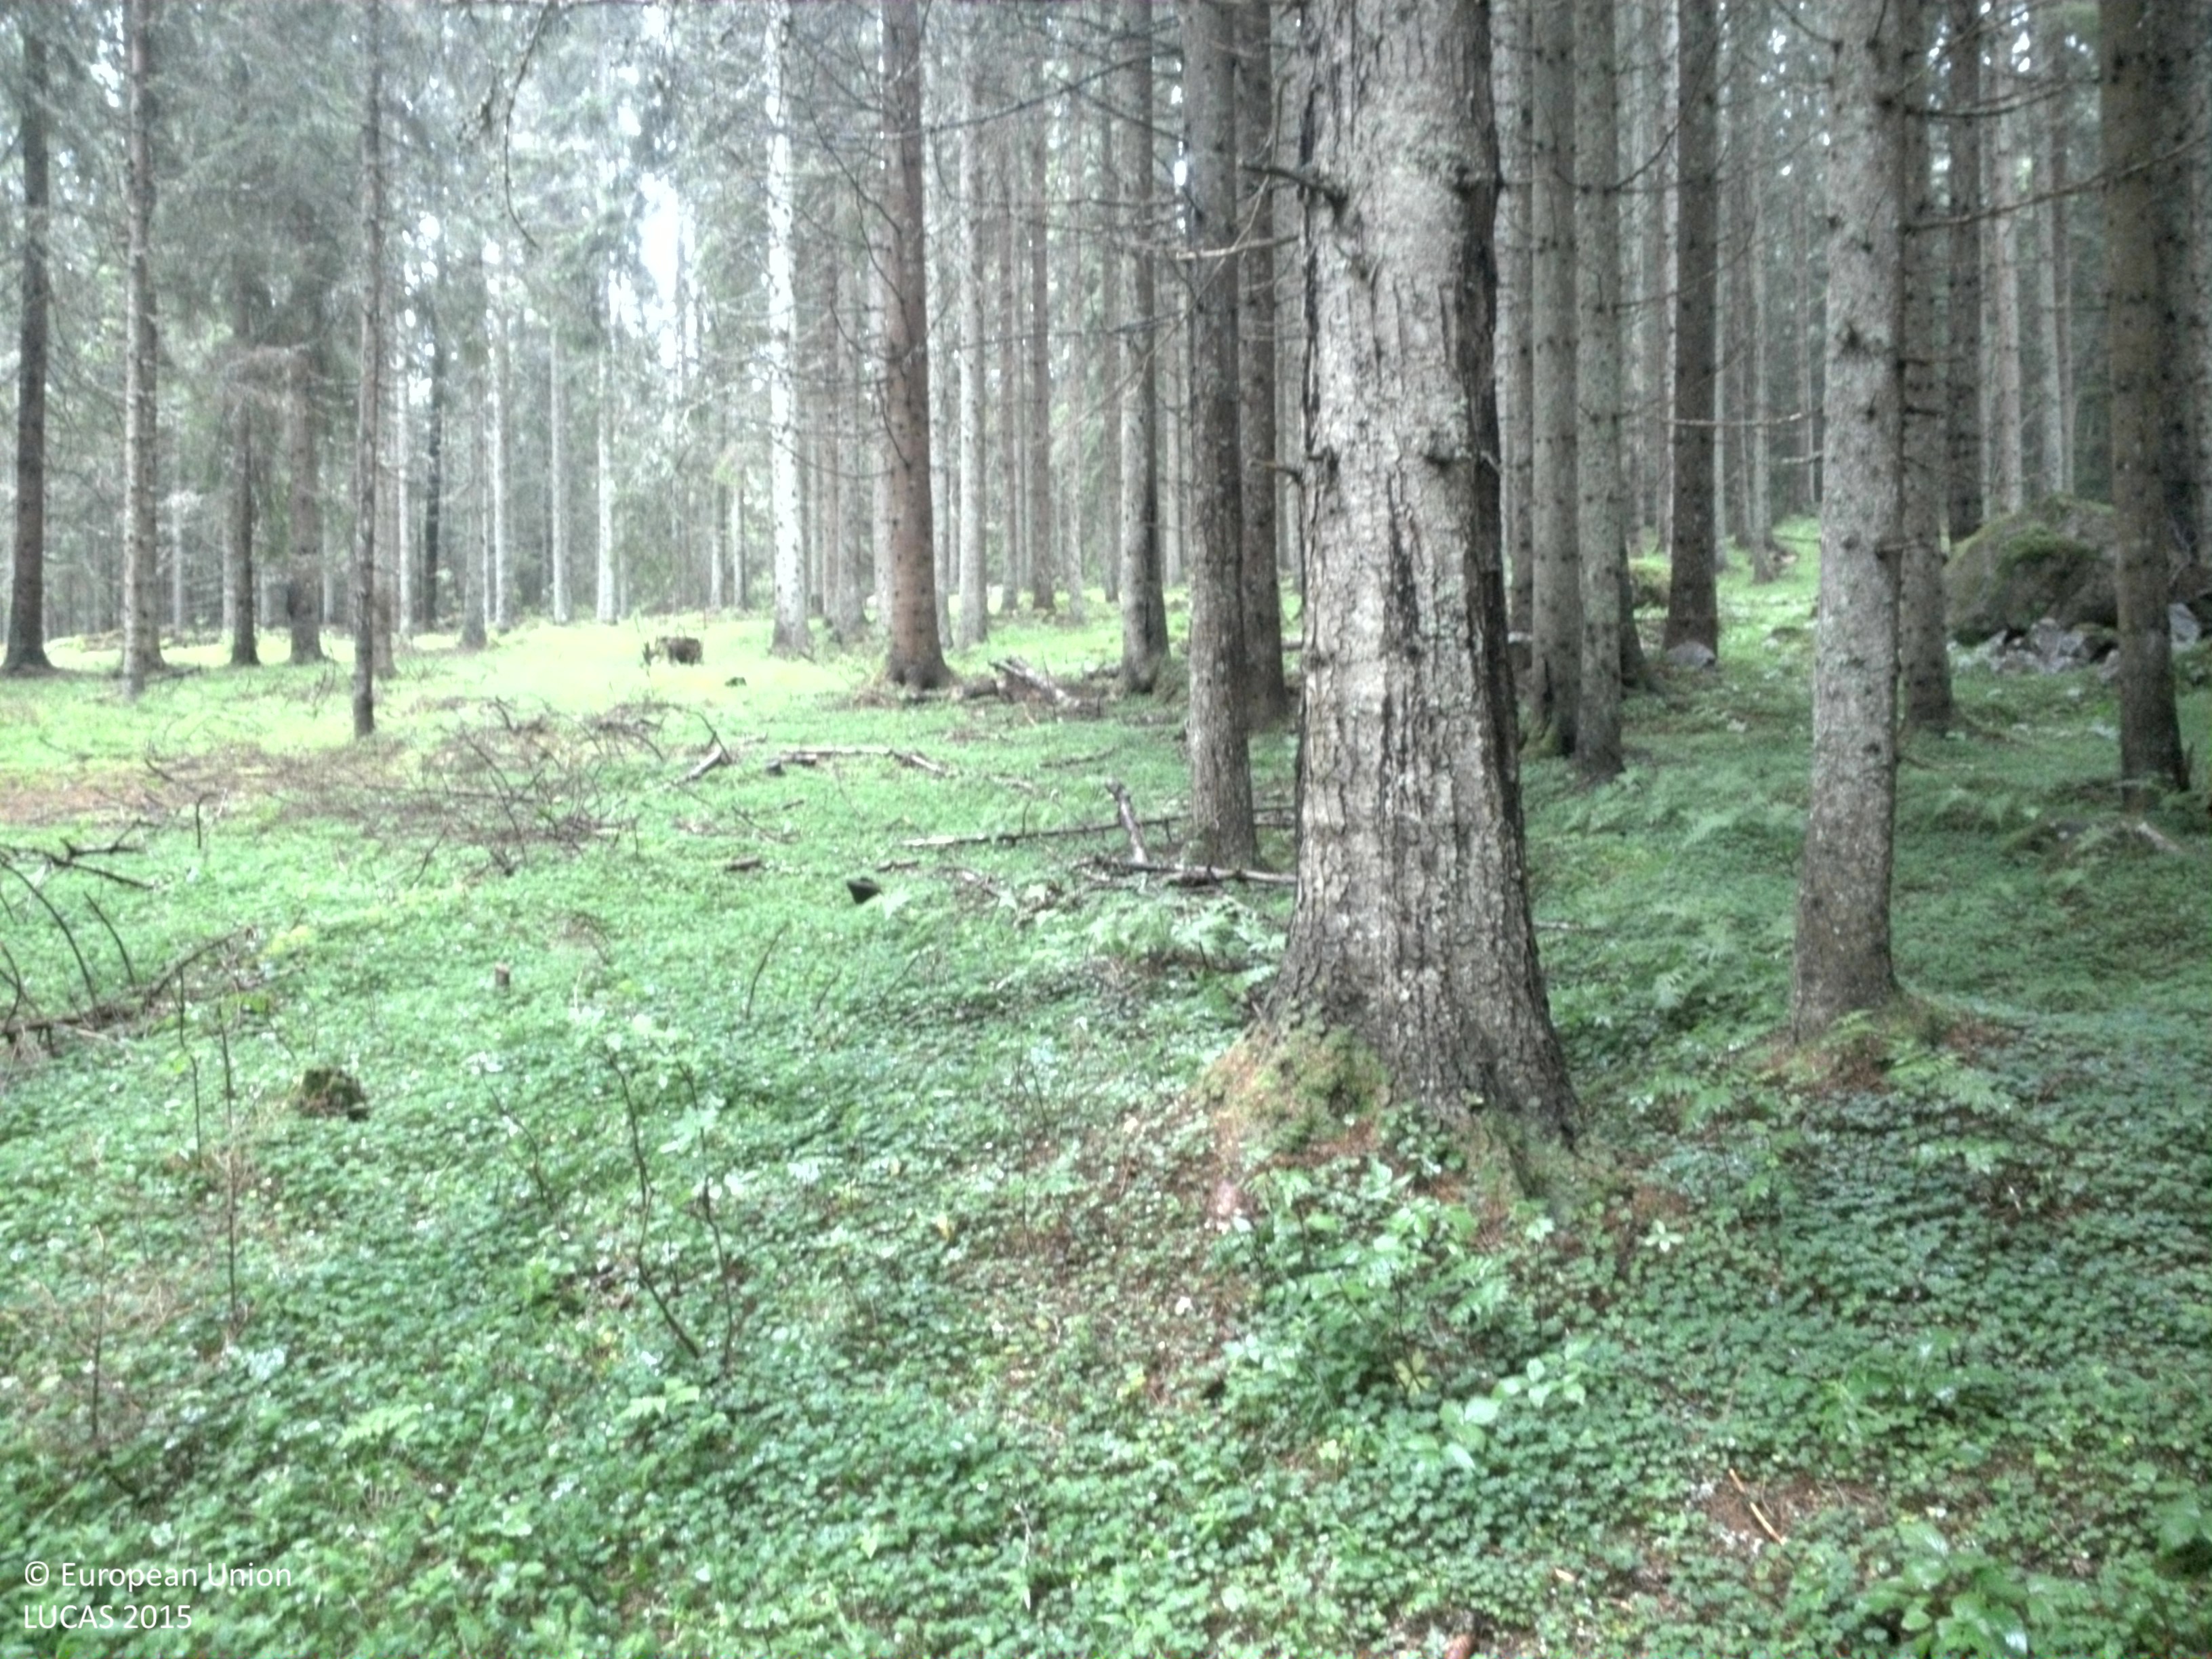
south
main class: Woodland
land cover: Spruce dominated coniferous woodland
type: boreal forest
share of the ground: > 75 %
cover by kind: coniferous forest trees 70 %, herbaceous plants 20 %, broadleaved forest trees 5 %, lichens and mosses 5 %
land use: Forestry
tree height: > 5 m
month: July
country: SE
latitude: 59.6876
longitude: 14.1295
